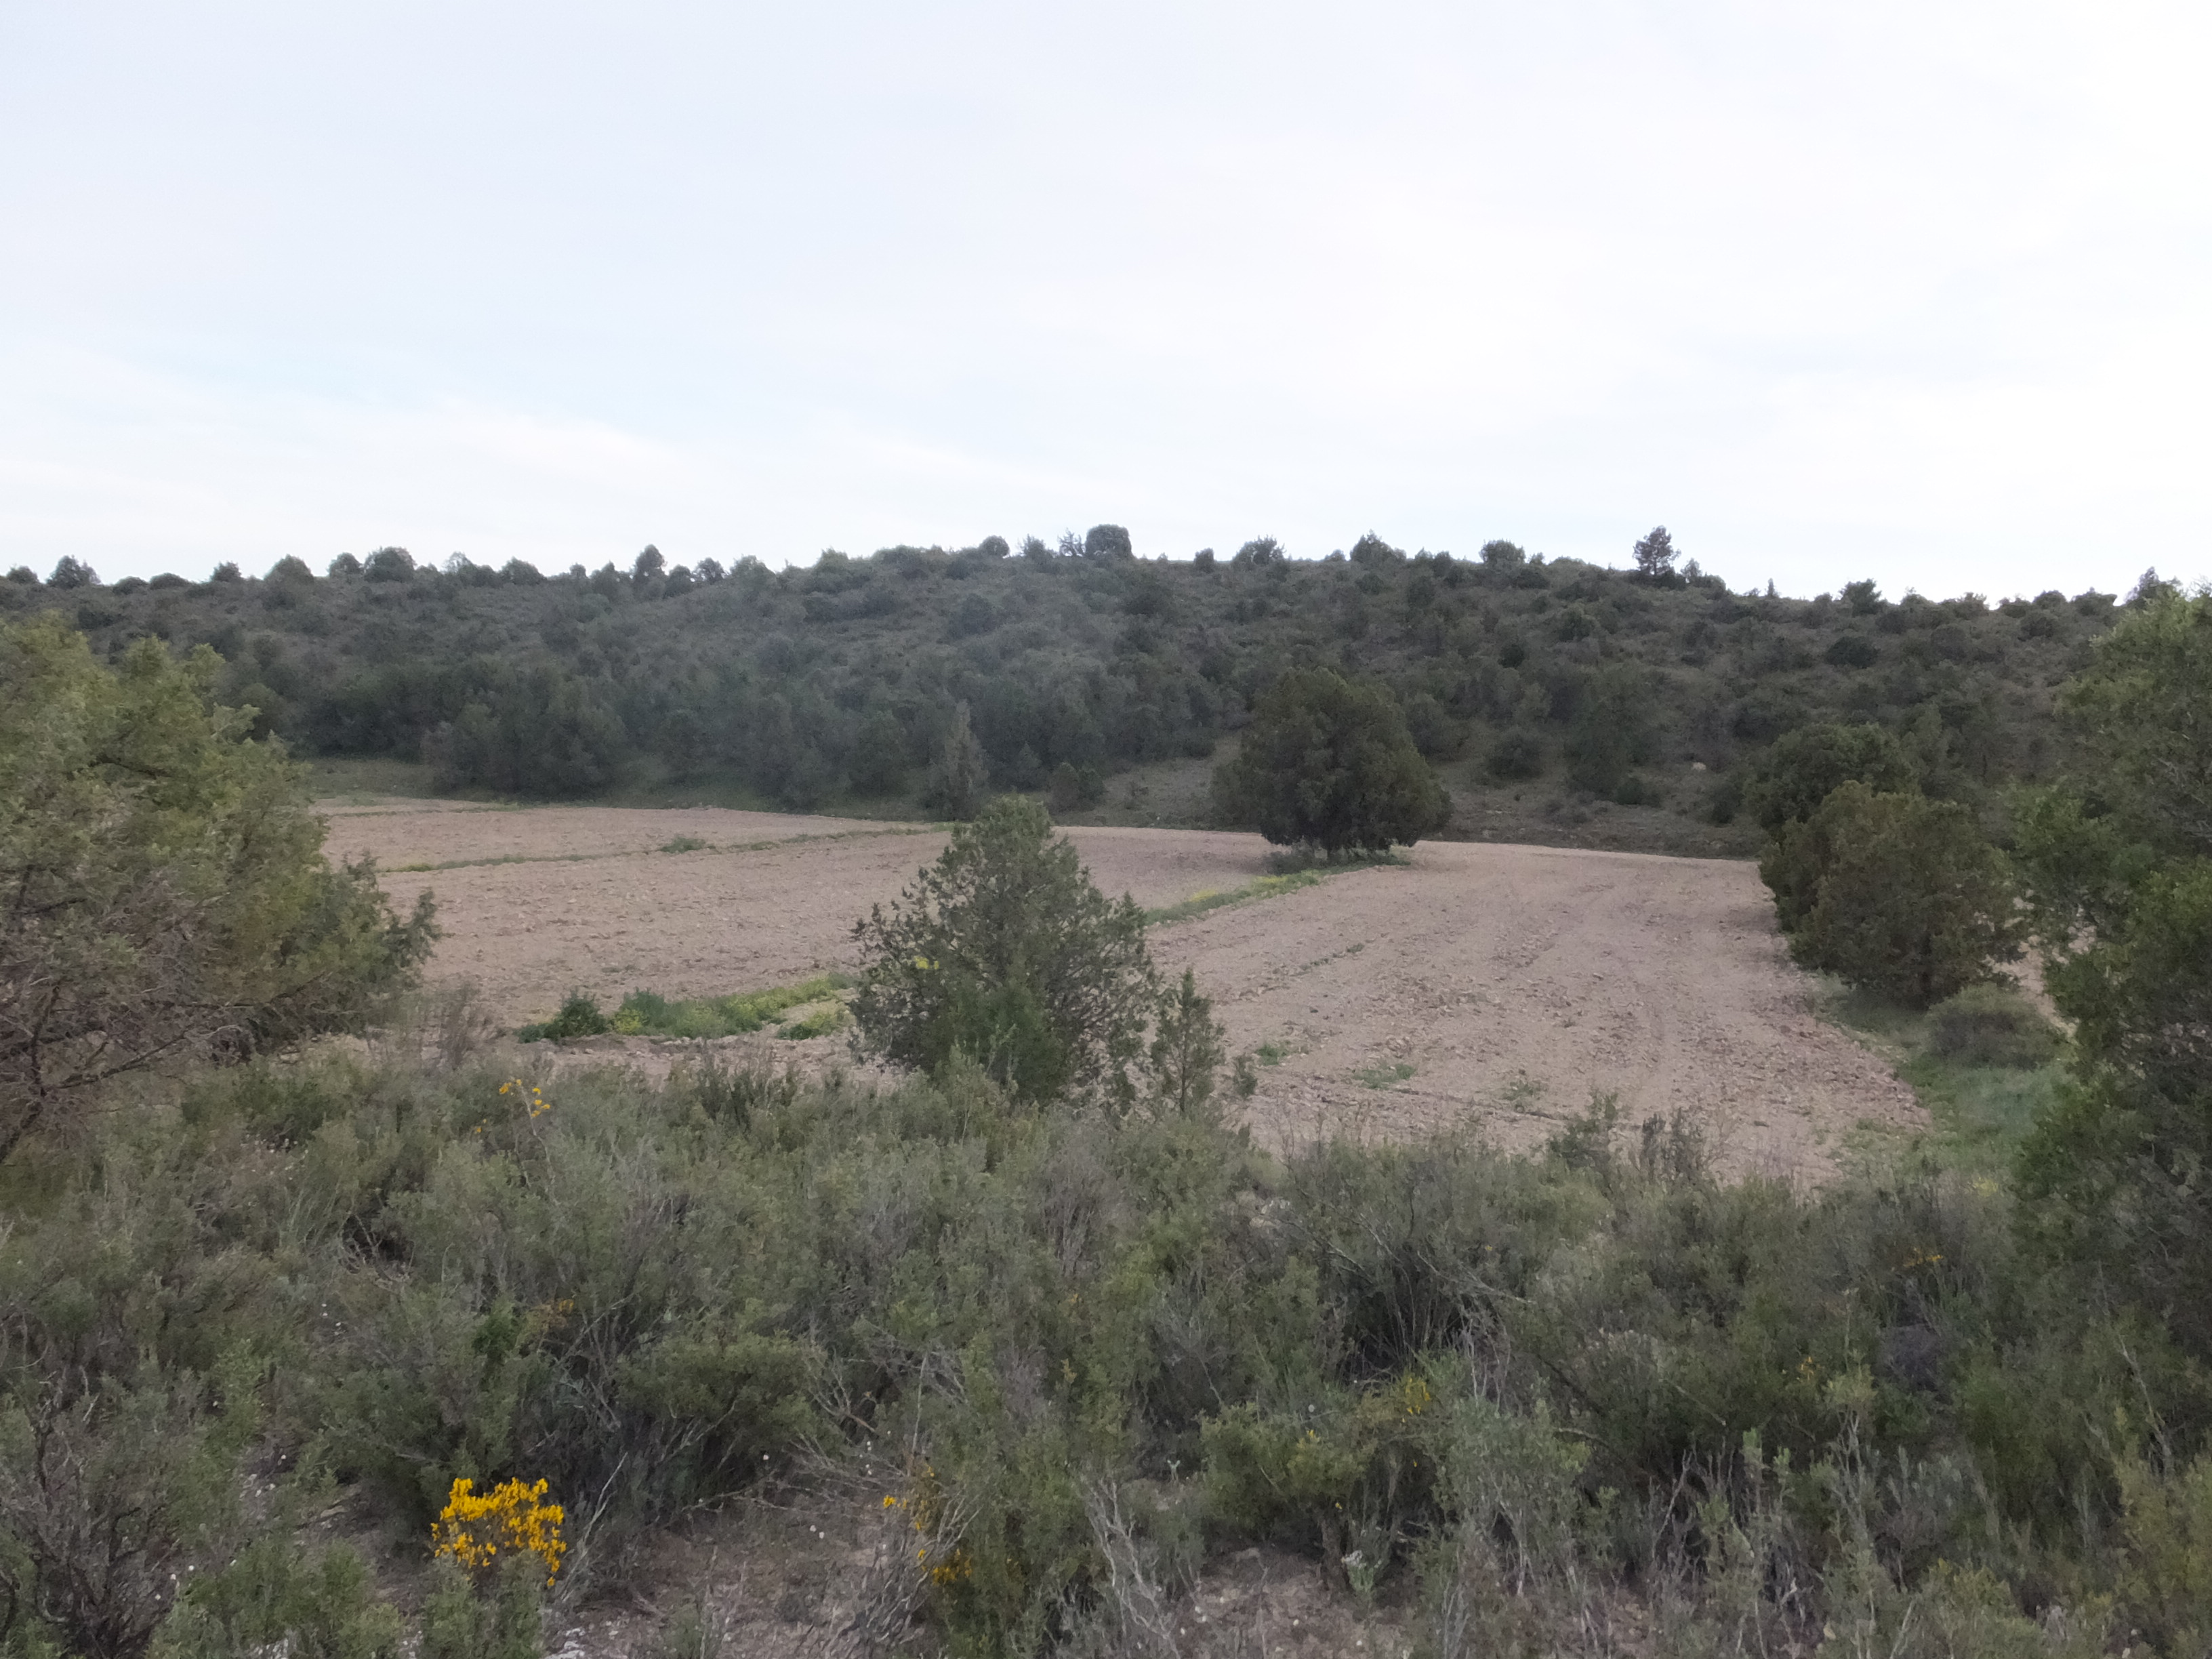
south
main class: Shrubland
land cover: Shrubland with sparse tree cover
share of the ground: > 75 %
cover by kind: shrubs 75 %, herbaceous plants 20 %, coniferous forest trees 5 %
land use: Semi-natural and natural areas not in use
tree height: > 5 m
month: April
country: ES
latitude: 41.6715
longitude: -0.3115
